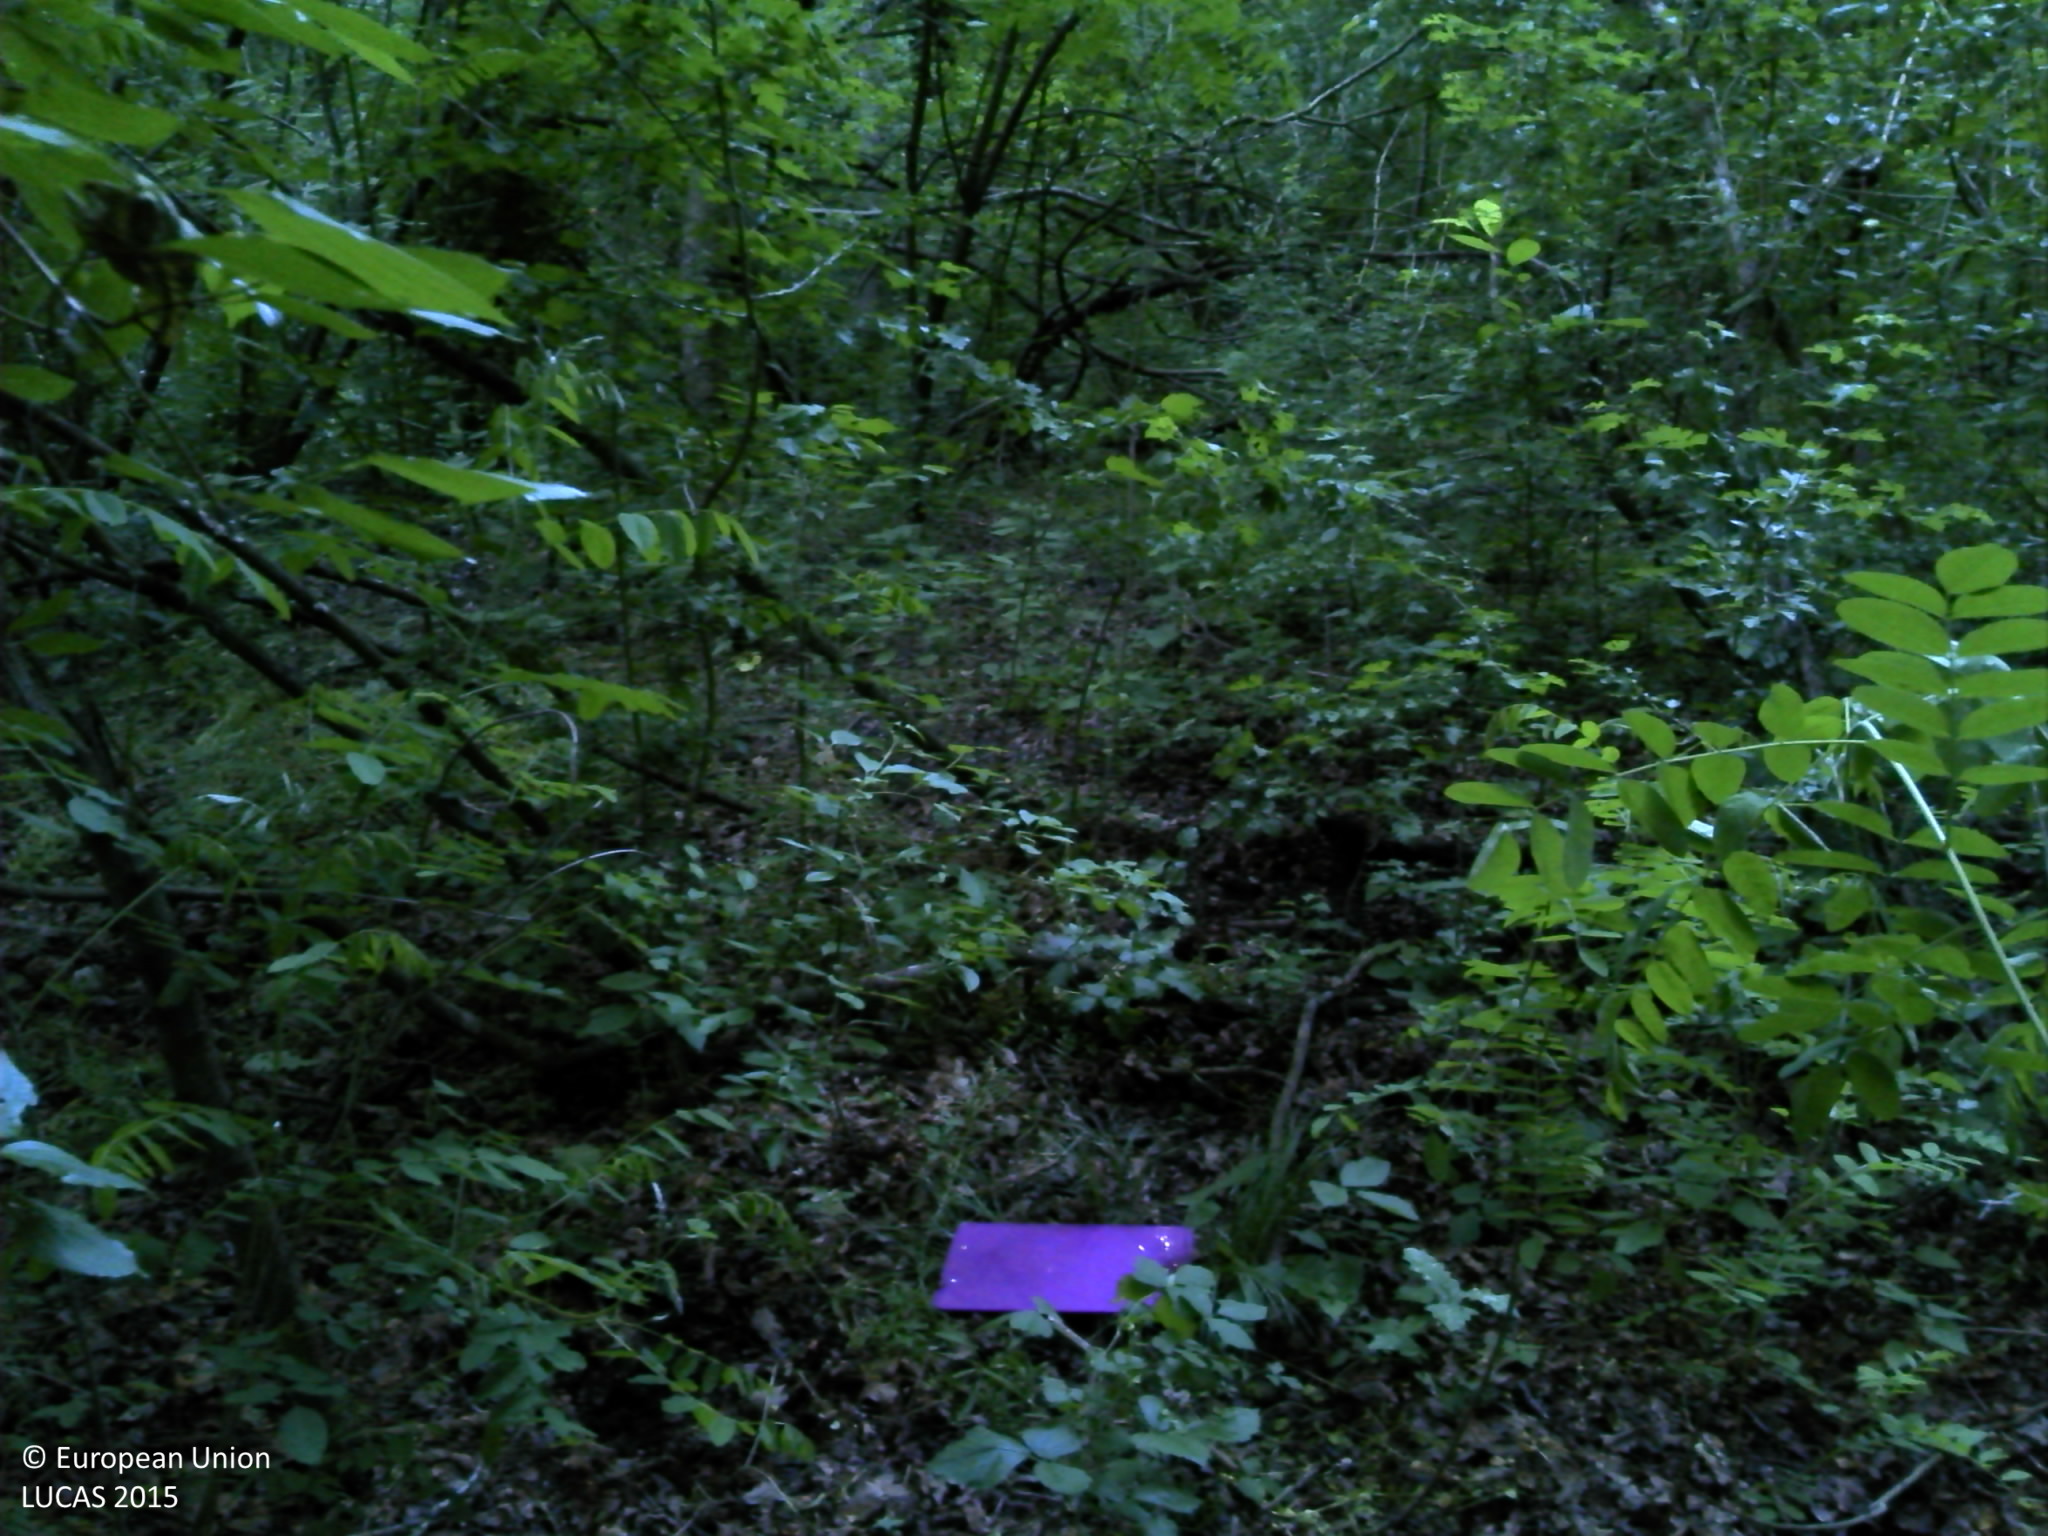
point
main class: Woodland
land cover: Broadleaved woodland
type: acidophilous oak and oak-birch forest
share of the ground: > 75 %
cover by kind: broadleaved forest trees 90 %, shrubs 10 %
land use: Forestry
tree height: > 5 m
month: May
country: HR
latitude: 45.1127
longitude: 18.8662
